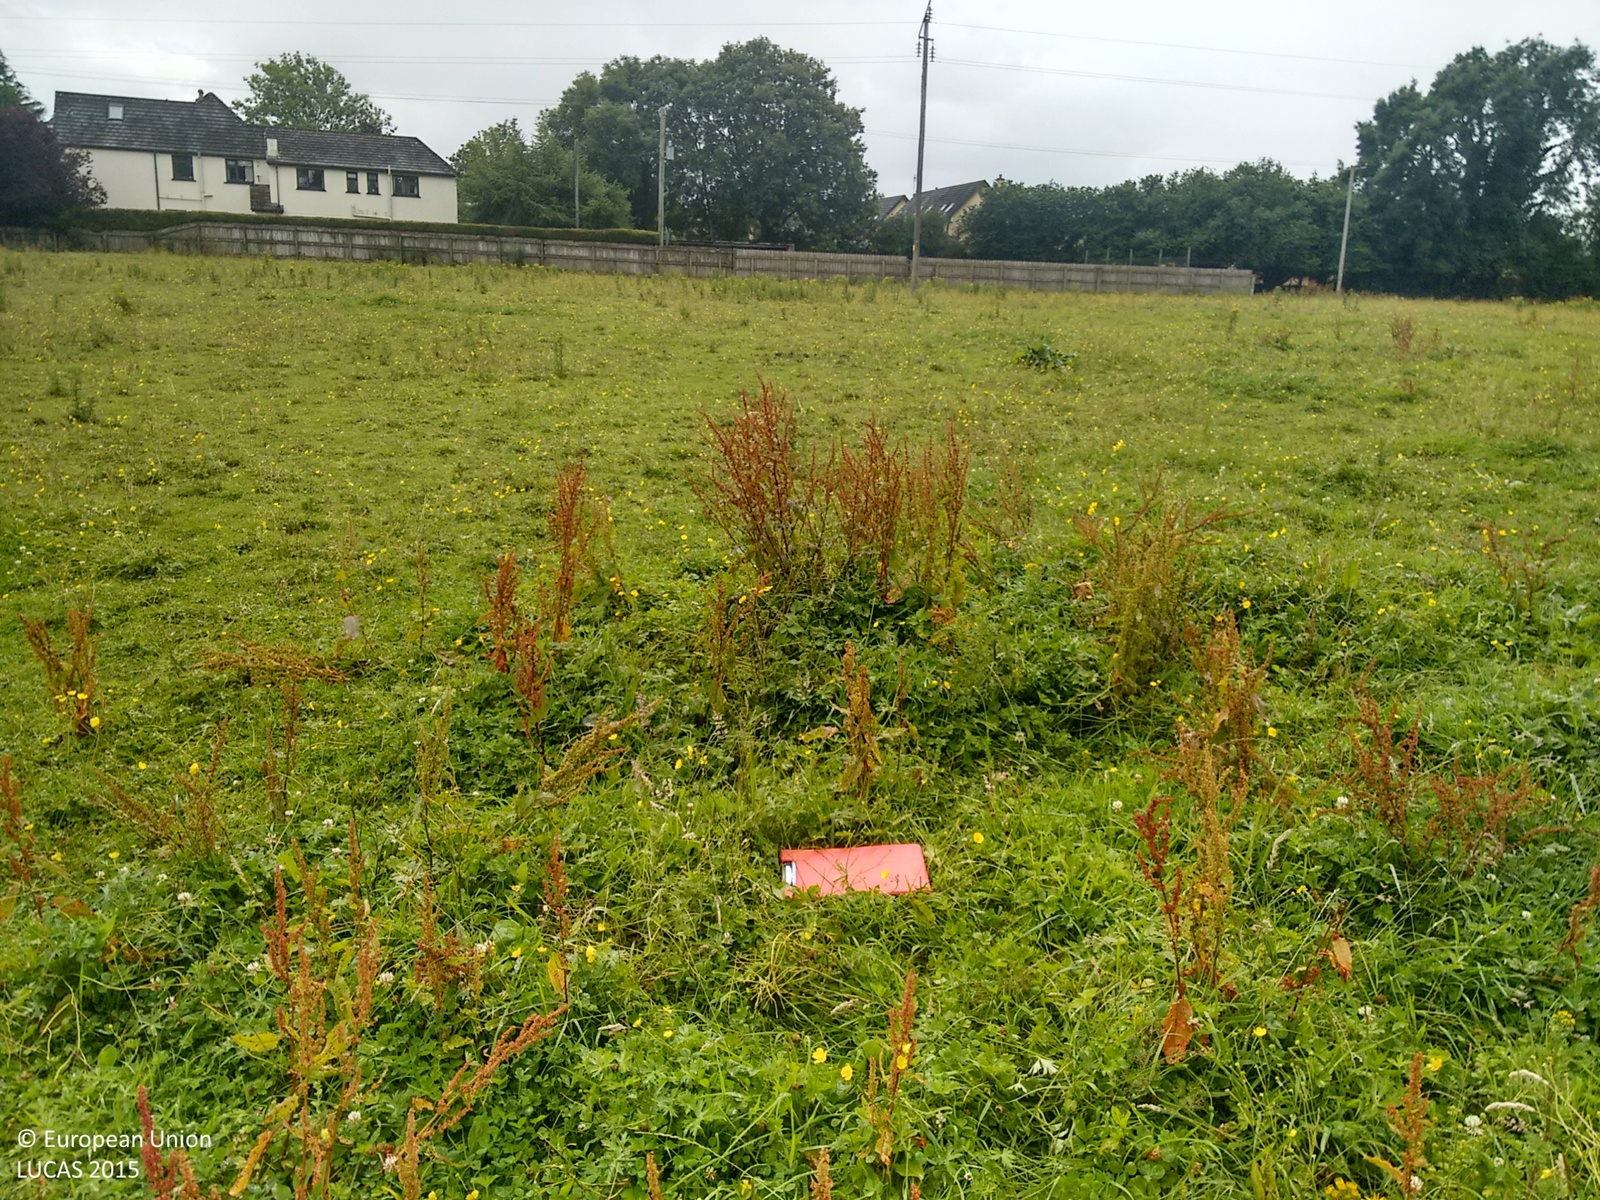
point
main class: Grassland
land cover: Grassland without tree/shrub cover
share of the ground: > 75 %
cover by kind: herbaceous plants 100 %
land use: Agriculture (excluding fallow land and kitchen gardens)
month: July
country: IE
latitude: 53.7454
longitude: -7.8026
